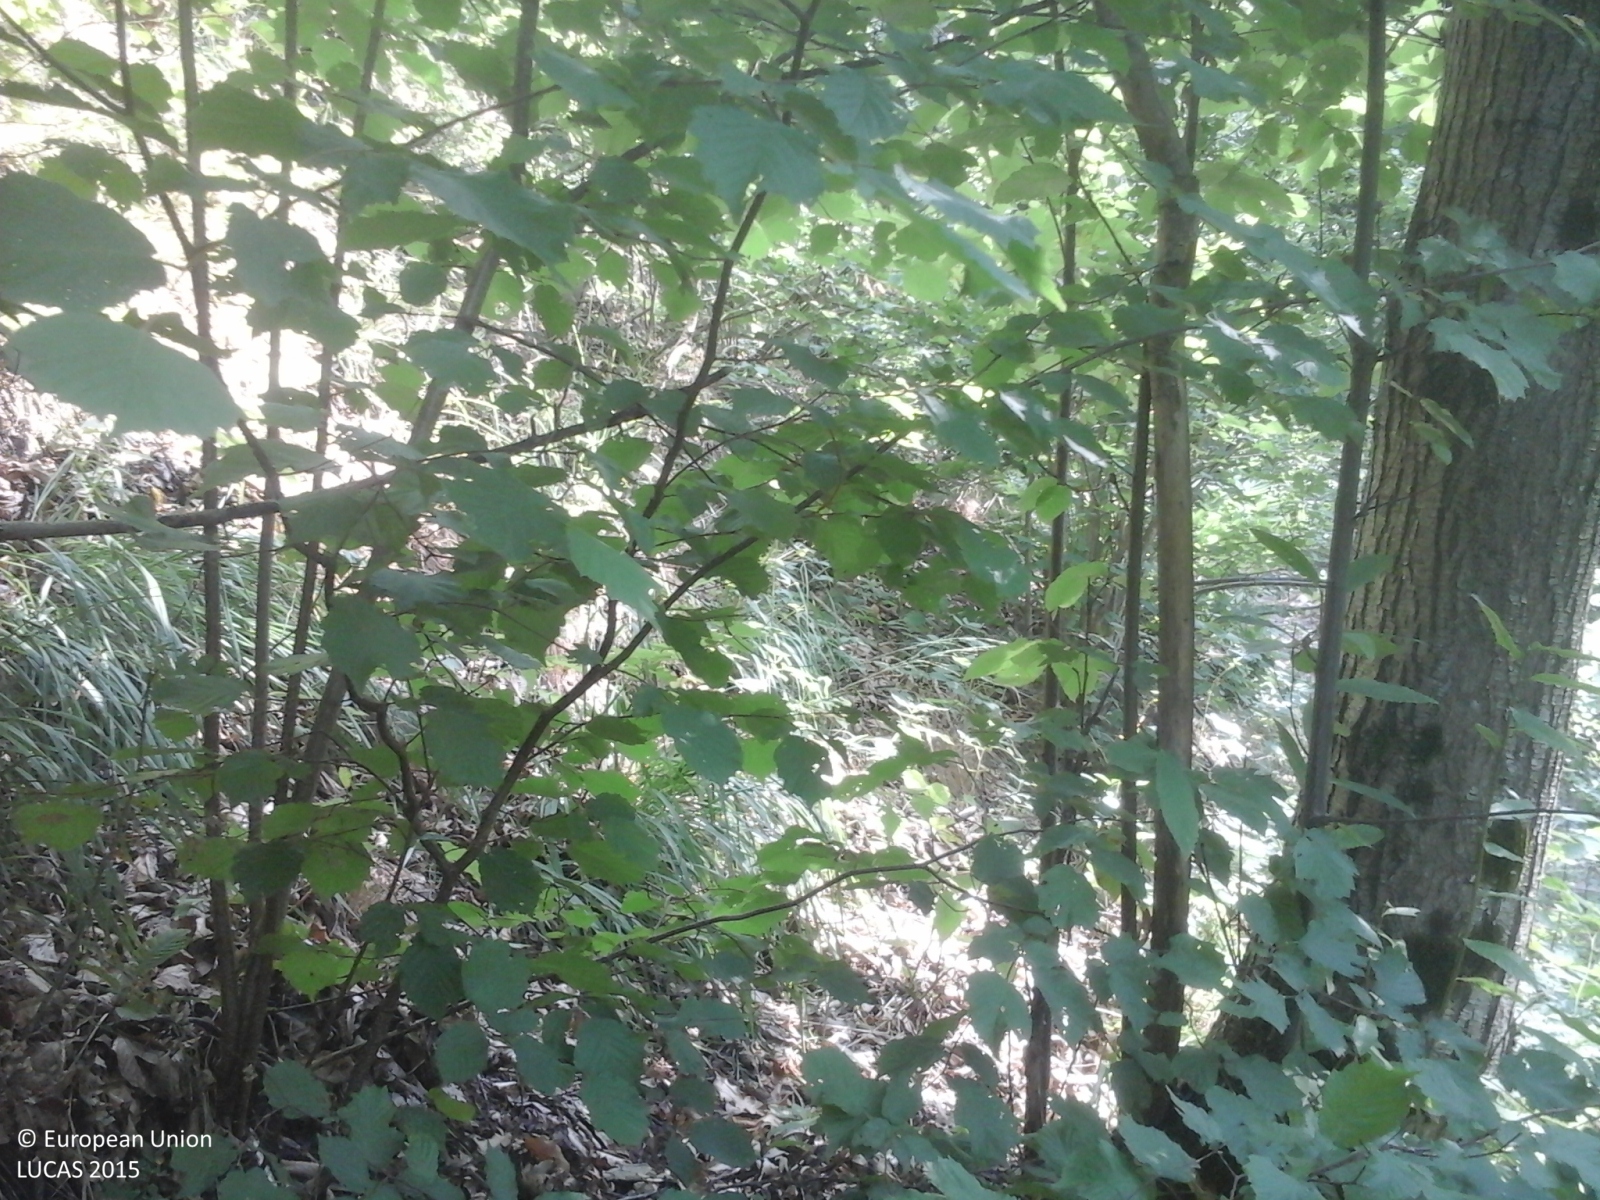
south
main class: Woodland
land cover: Broadleaved woodland
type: thermophilous deciduous forest
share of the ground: > 75 %
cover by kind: broadleaved forest trees 100 %
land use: Forestry
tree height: > 5 m
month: August
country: IT
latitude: 46.0432
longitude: 9.3935
